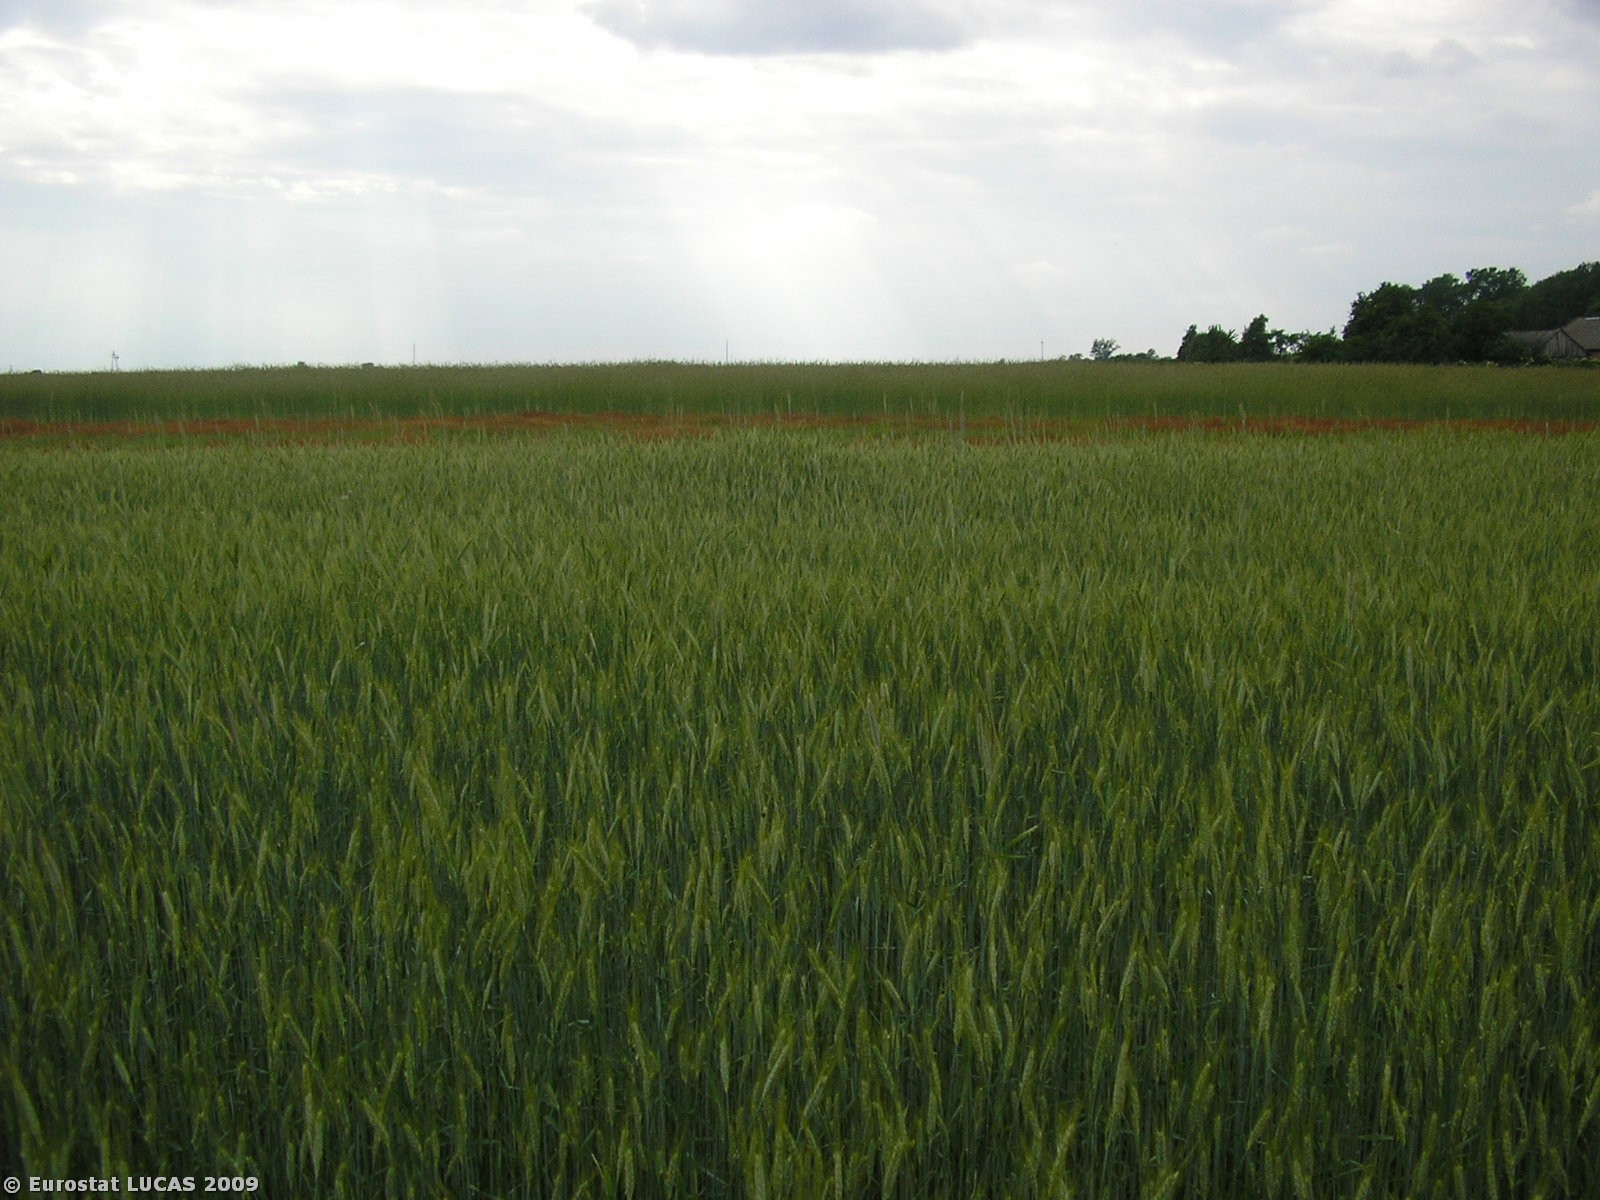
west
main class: Cropland
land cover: Triticale
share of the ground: 50 - 75 %
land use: Agriculture (excluding fallow land and kitchen gardens)
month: June
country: PL
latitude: 51.2342
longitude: 18.3394
